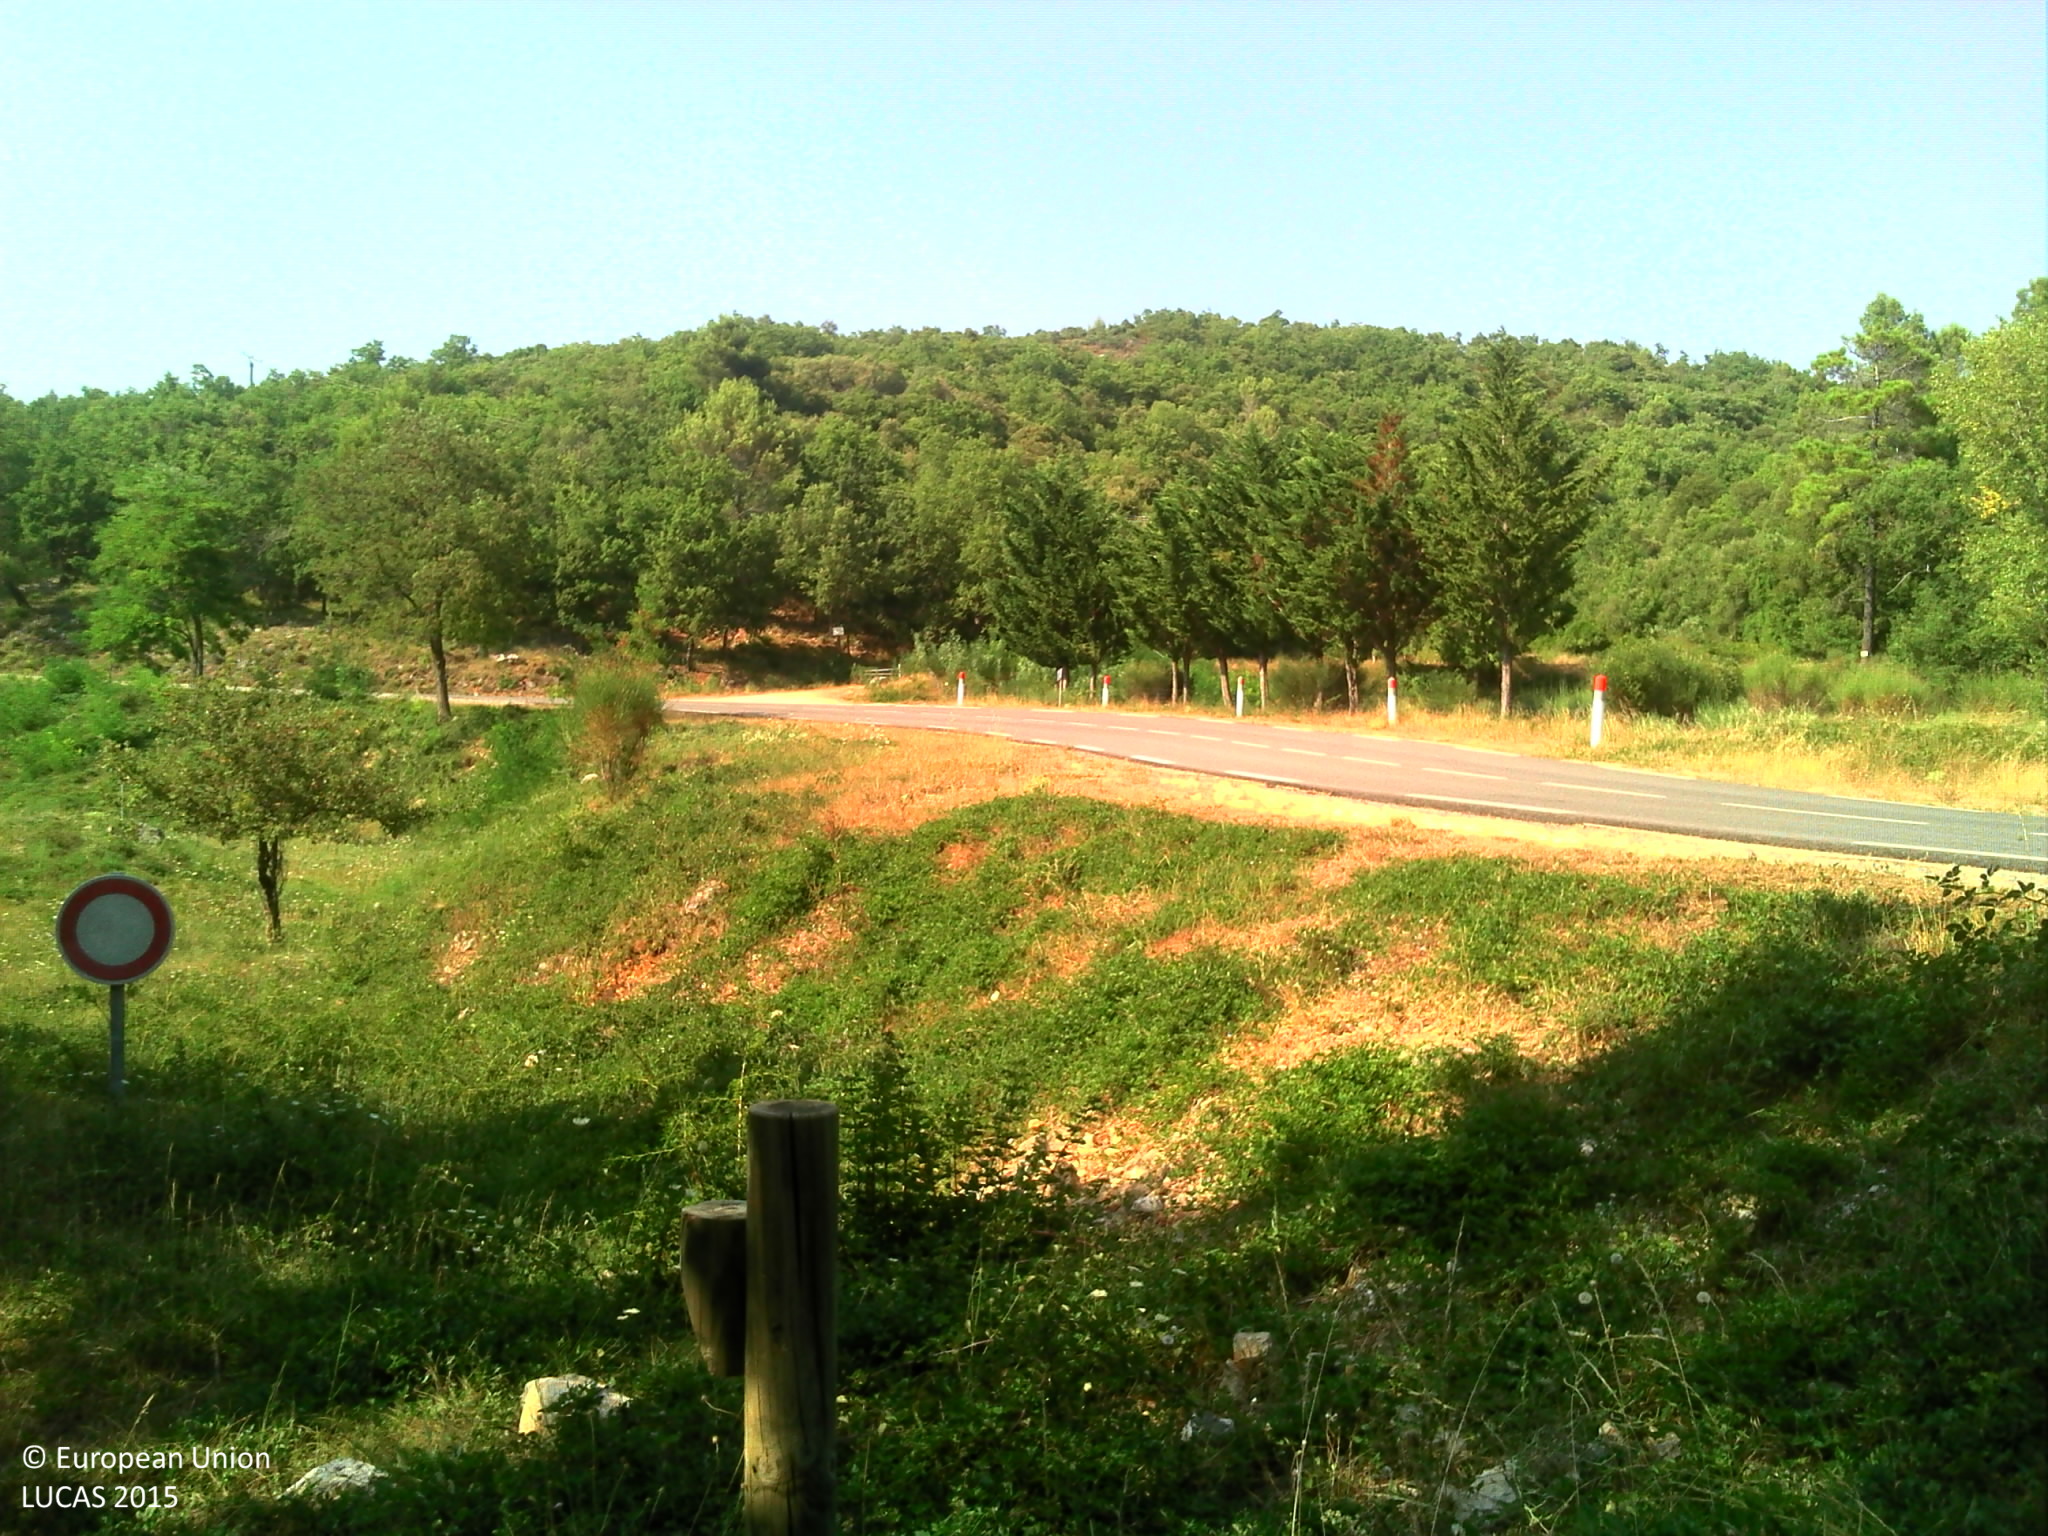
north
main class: Shrubland
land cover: Shrubland with sparse tree cover
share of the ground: > 75 %
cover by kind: shrubs 85 %, unconsolidated bare surface 10 %, broadleaved forest trees 5 %
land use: Community services
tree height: < 5 m
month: August
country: FR
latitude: 43.6415
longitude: 6.5000
